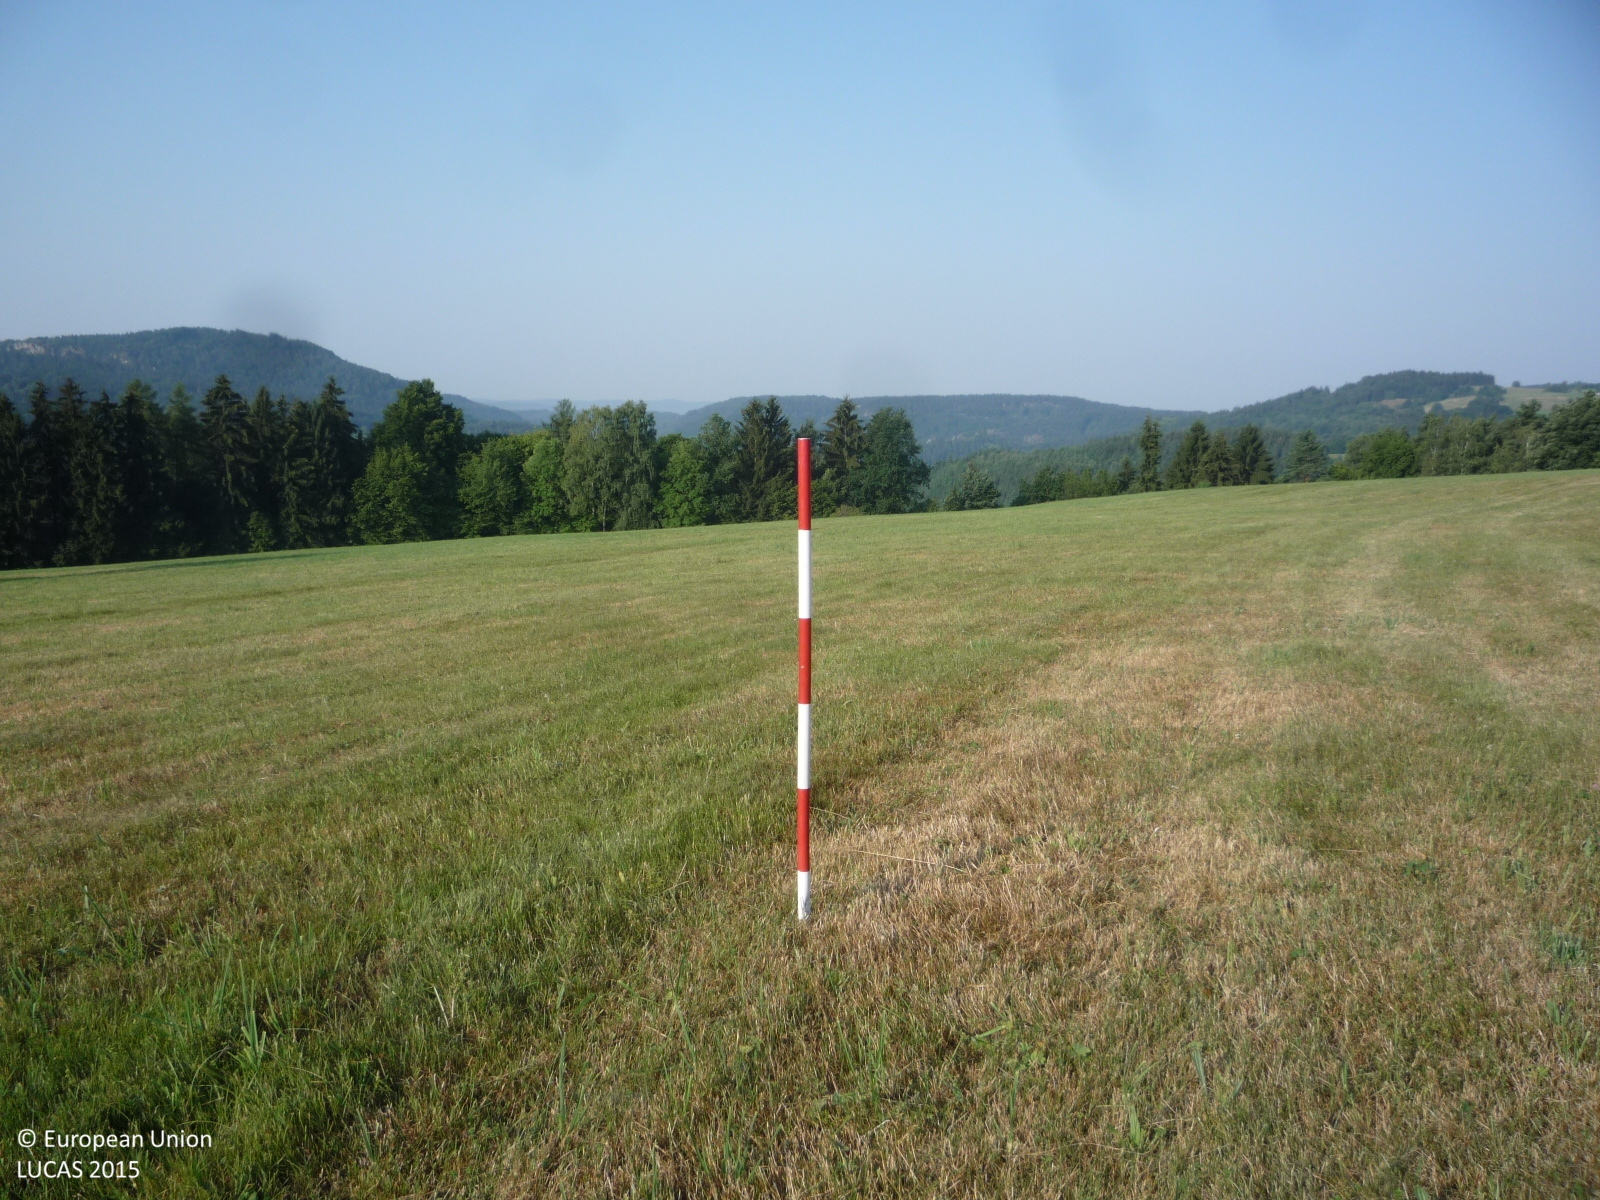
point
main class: Grassland
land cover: Grassland without tree/shrub cover
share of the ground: > 75 %
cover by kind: herbaceous plants 100 %
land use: Agriculture (excluding fallow land and kitchen gardens)
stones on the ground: < 10 %
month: August
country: CZ
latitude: 50.6592
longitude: 15.2233
